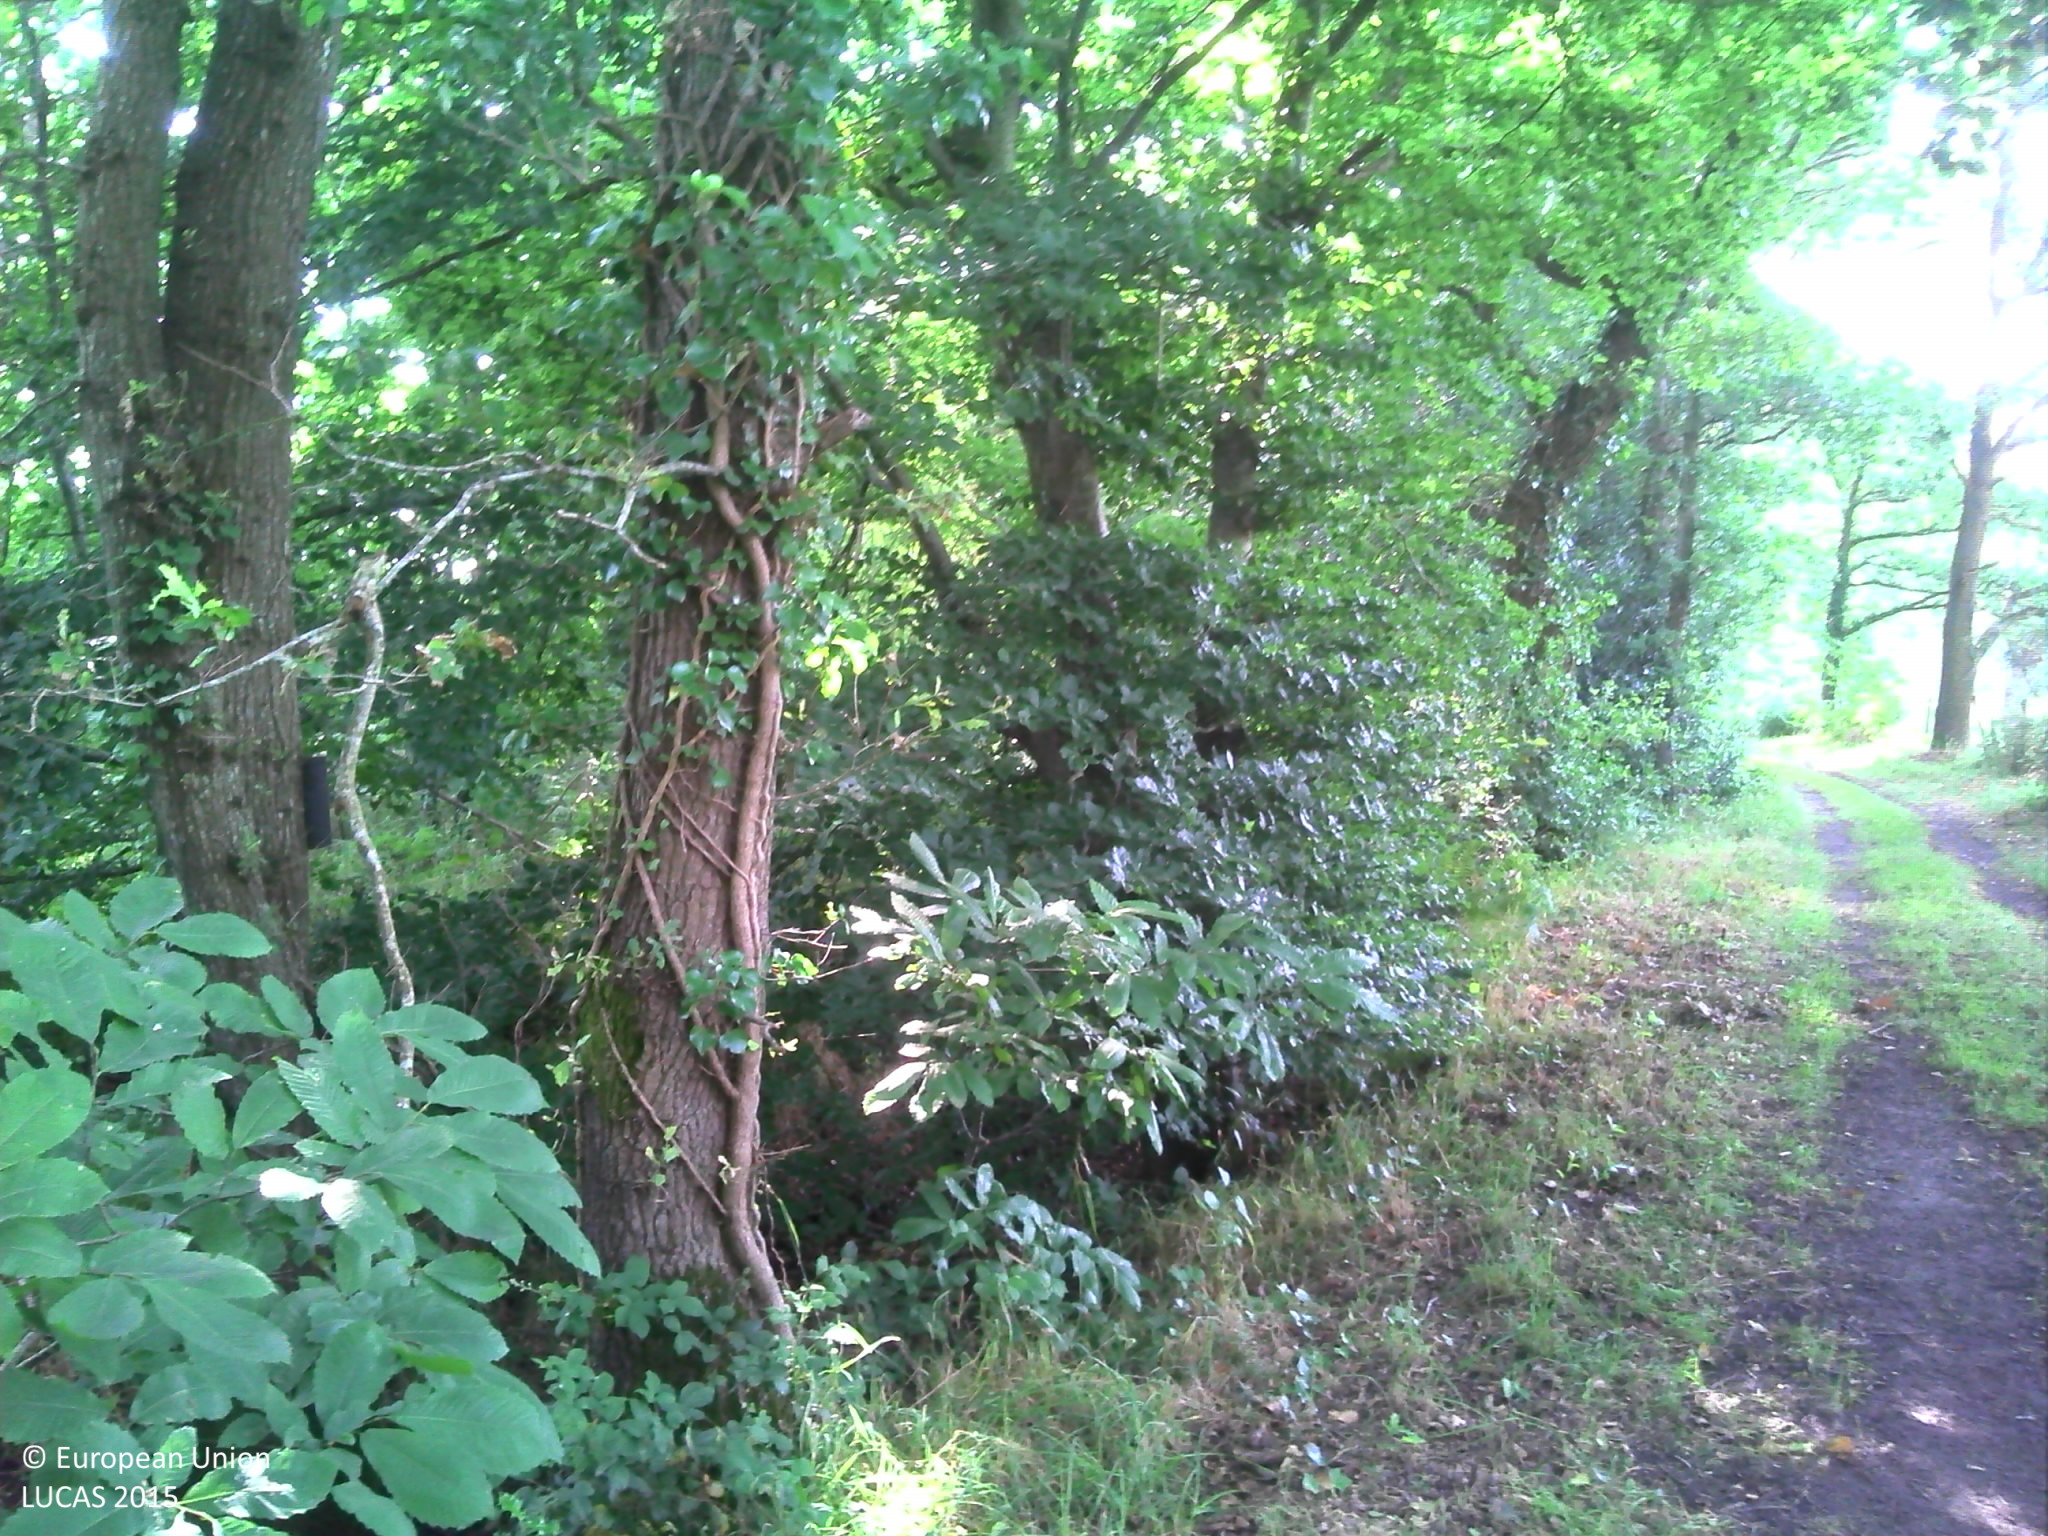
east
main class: Artificial land
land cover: Non built-up linear features
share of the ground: > 75 %
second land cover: Grassland without tree/shrub cover
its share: > 75 %
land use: Road transport
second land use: Agriculture (excluding fallow land and kitchen gardens)
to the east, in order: Tracks; Broadleaved woodland; Ditches and canals; Broadleaved woodland; Shrubland without tree cover; Electric lines; Railways; Electric lines; Shrubland without tree cover; Grassland without tree/shrub cover; Fences; Broadleaved woodland; Grassland without tree/shrub cover
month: July
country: FR
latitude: 47.3229
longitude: -1.8888
